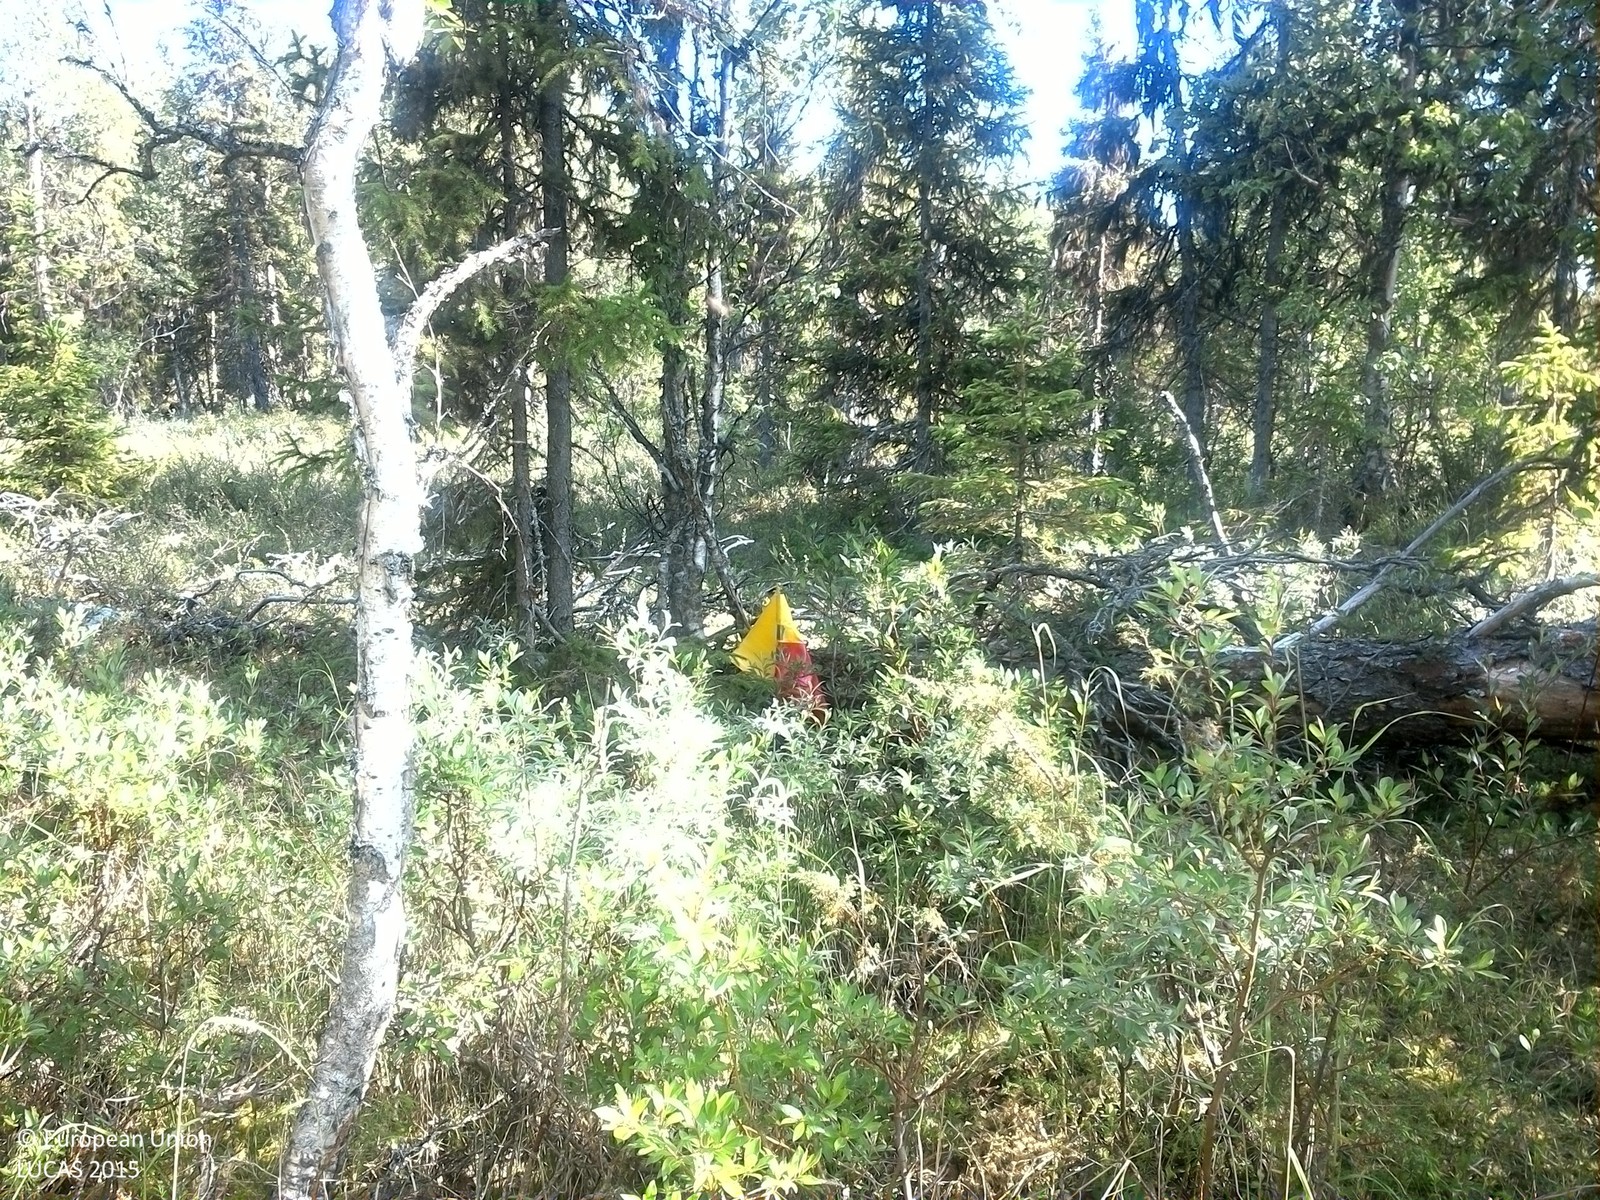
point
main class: Woodland
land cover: Spruce dominated coniferous woodland
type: mire and swamp forests
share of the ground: 25 - 50 %
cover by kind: coniferous forest trees 40 %, shrubs 25 %, lichens and mosses 25 %, broadleaved forest trees 5 %, herbaceous plants 5 %
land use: Semi-natural and natural areas not in use
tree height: > 5 m
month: July
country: SE
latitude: 64.5656
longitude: 15.7496
